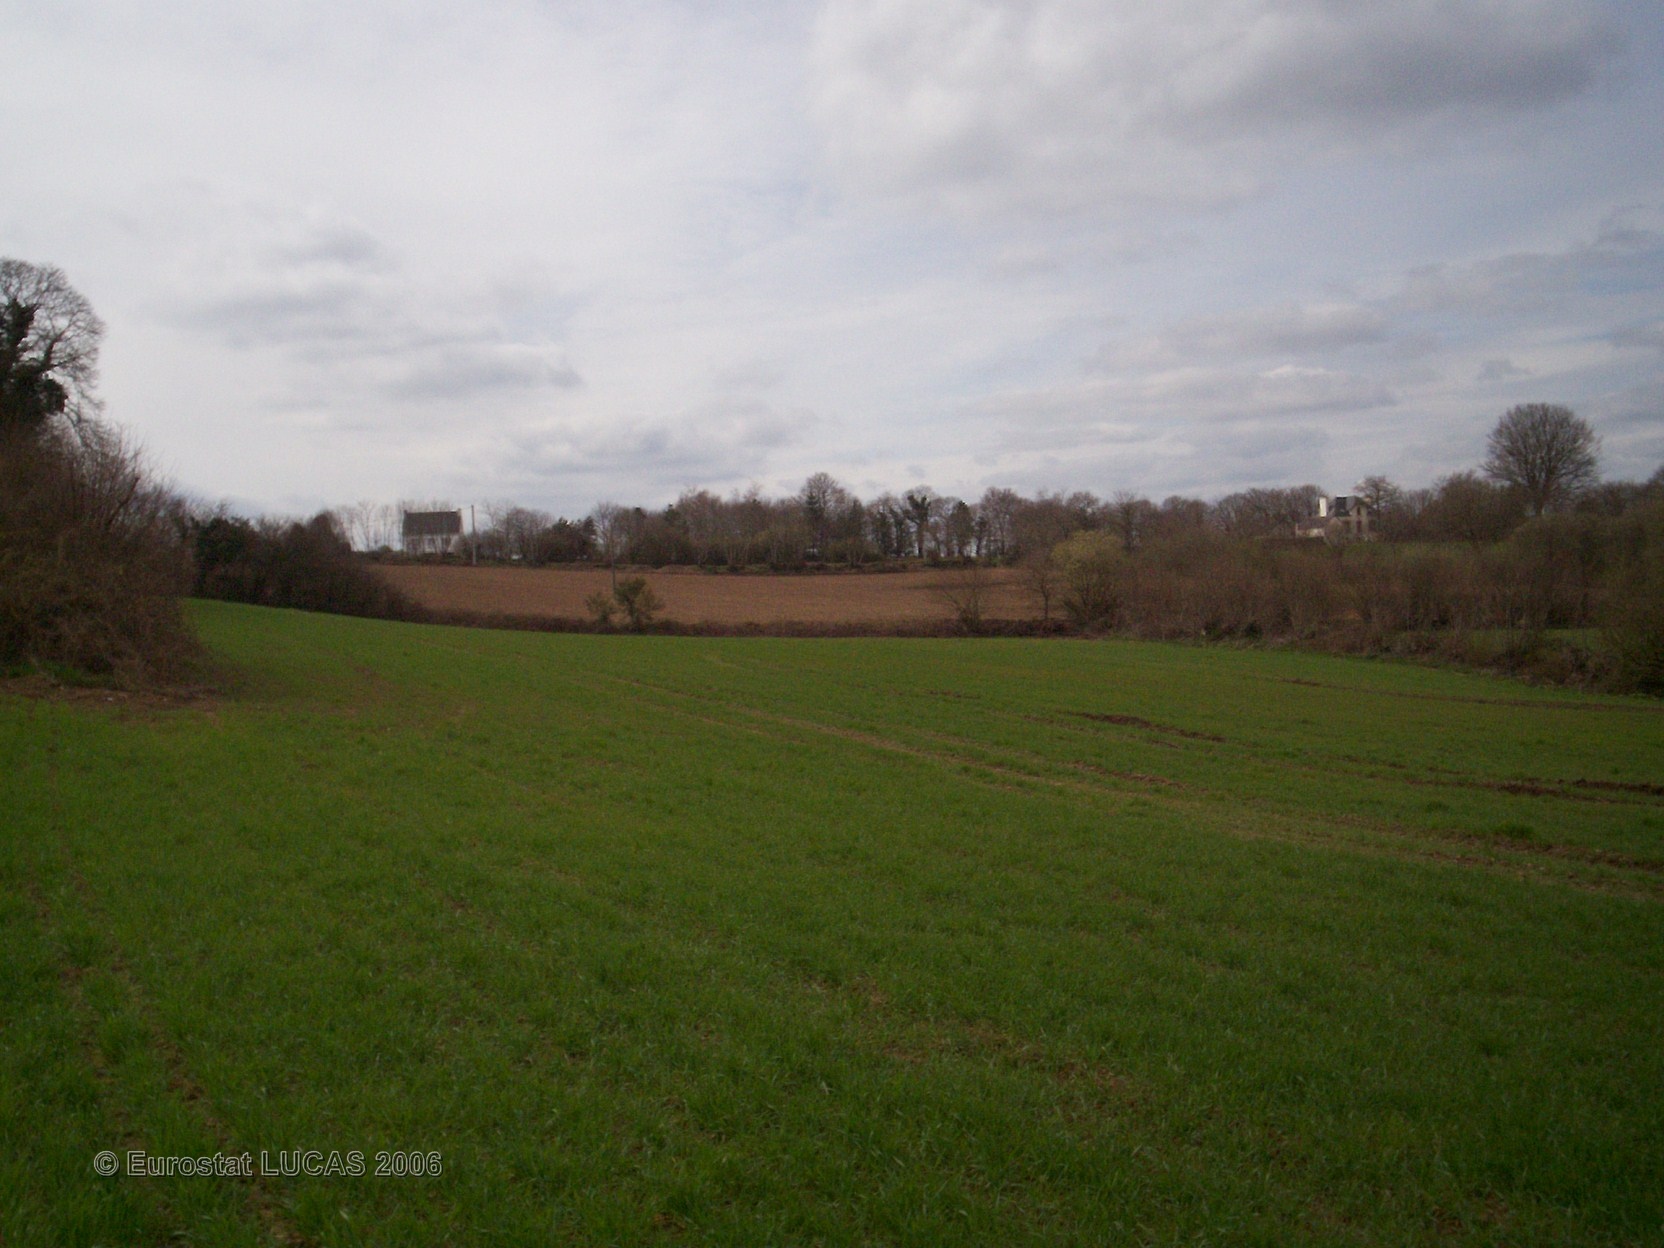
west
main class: Cropland
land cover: Common wheat
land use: Agriculture (excluding fallow land and kitchen gardens)
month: April
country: FR
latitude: 48.1262
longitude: -3.5813
